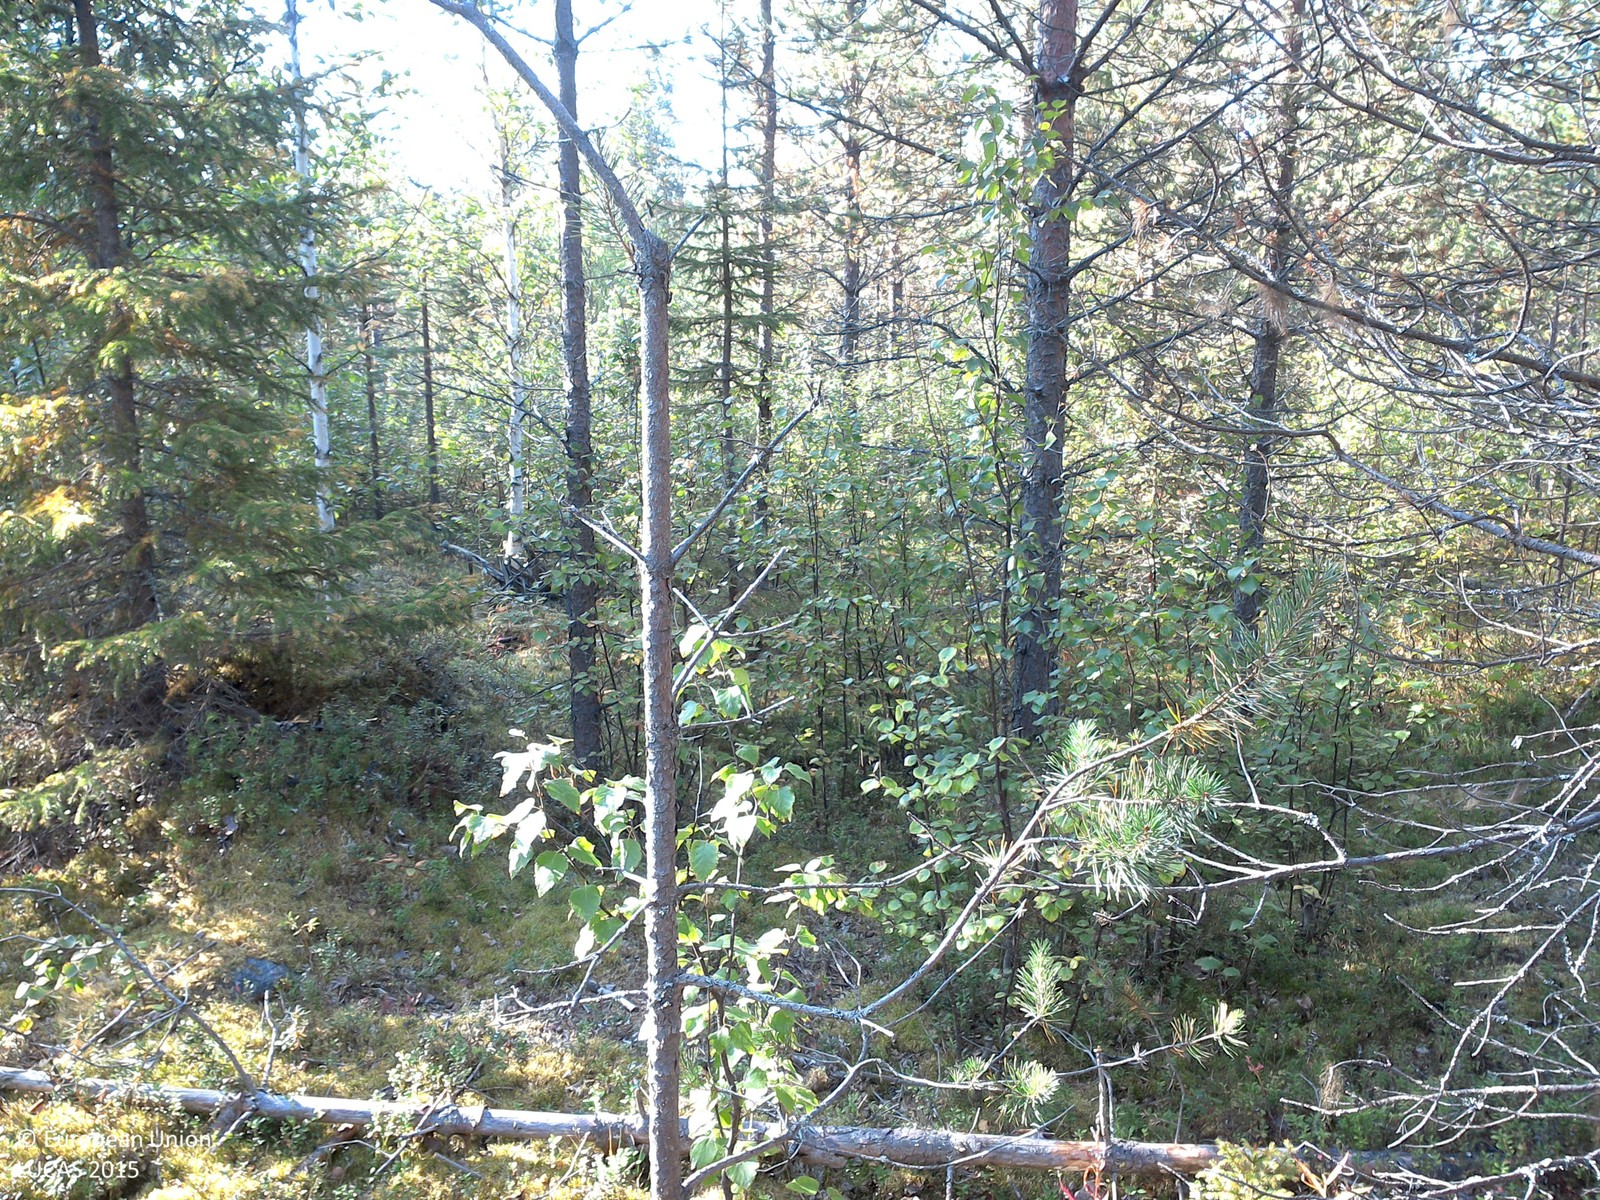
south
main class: Woodland
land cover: Pine dominated mixed woodland
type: boreal forest
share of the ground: 25 - 50 %
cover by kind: coniferous forest trees 30 %, lichens and mosses 30 %, shrubs 25 %, broadleaved forest trees 15 %
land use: Forestry
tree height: > 5 m
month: August
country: SE
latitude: 67.2023
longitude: 22.5669
